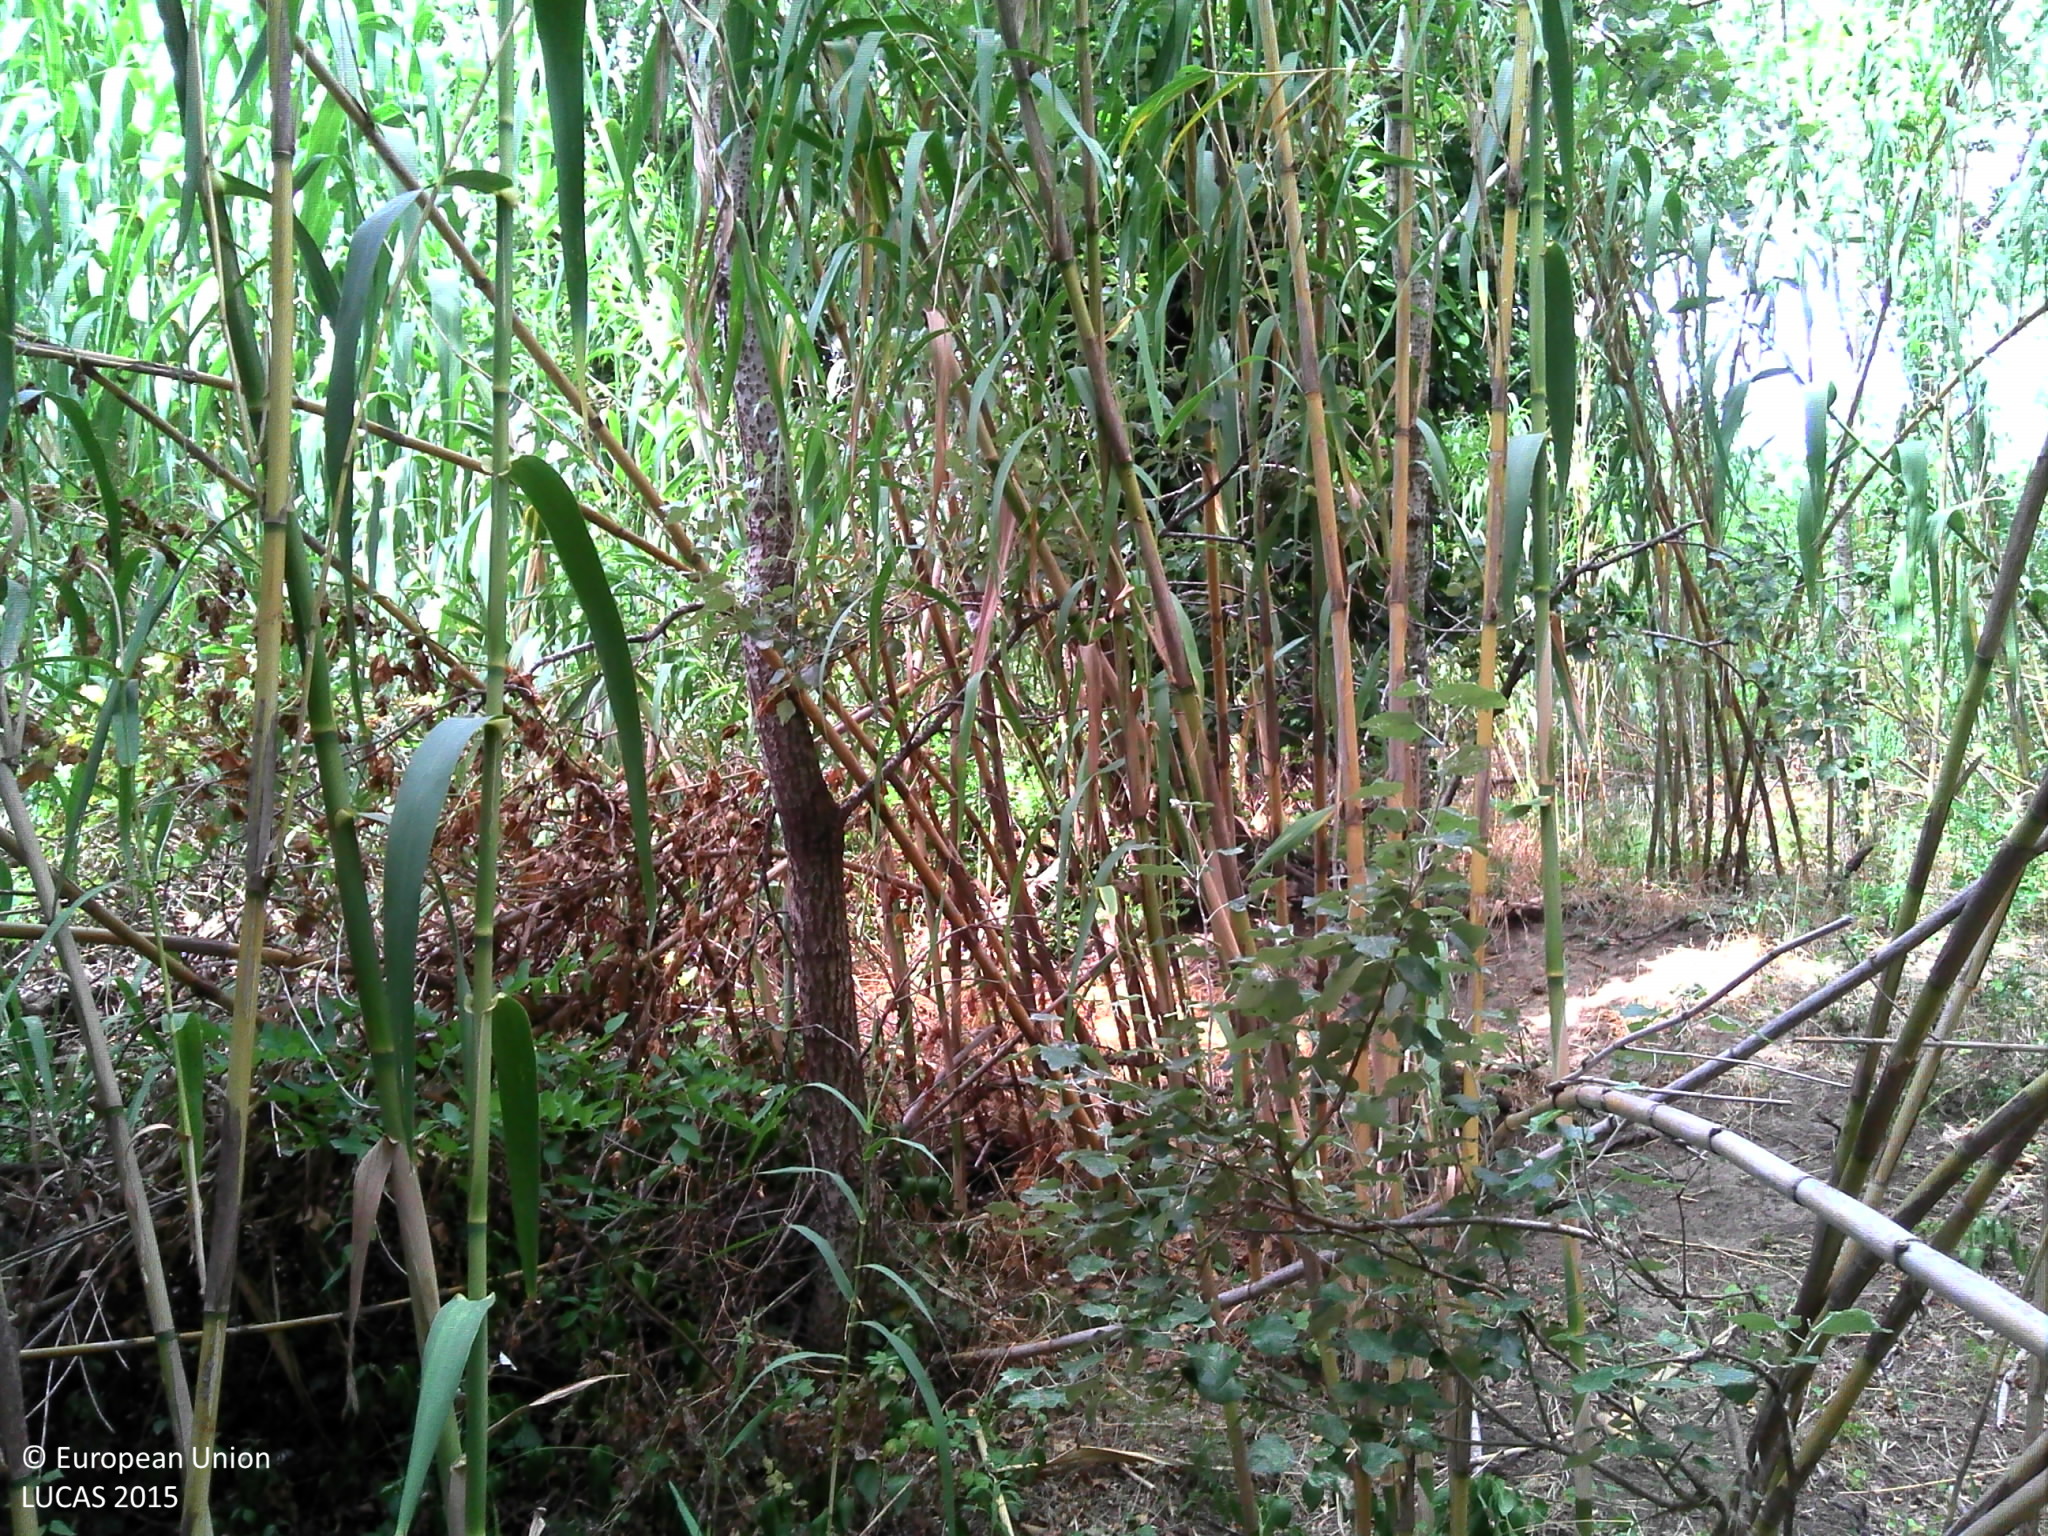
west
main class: Woodland
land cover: Broadleaved woodland
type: mesophytic deciduous forest
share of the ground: > 75 %
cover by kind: broadleaved forest trees 90 %, shrubs 10 %
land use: Semi-natural and natural areas not in use
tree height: > 5 m
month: July
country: FR
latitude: 42.6857
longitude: 2.7744
